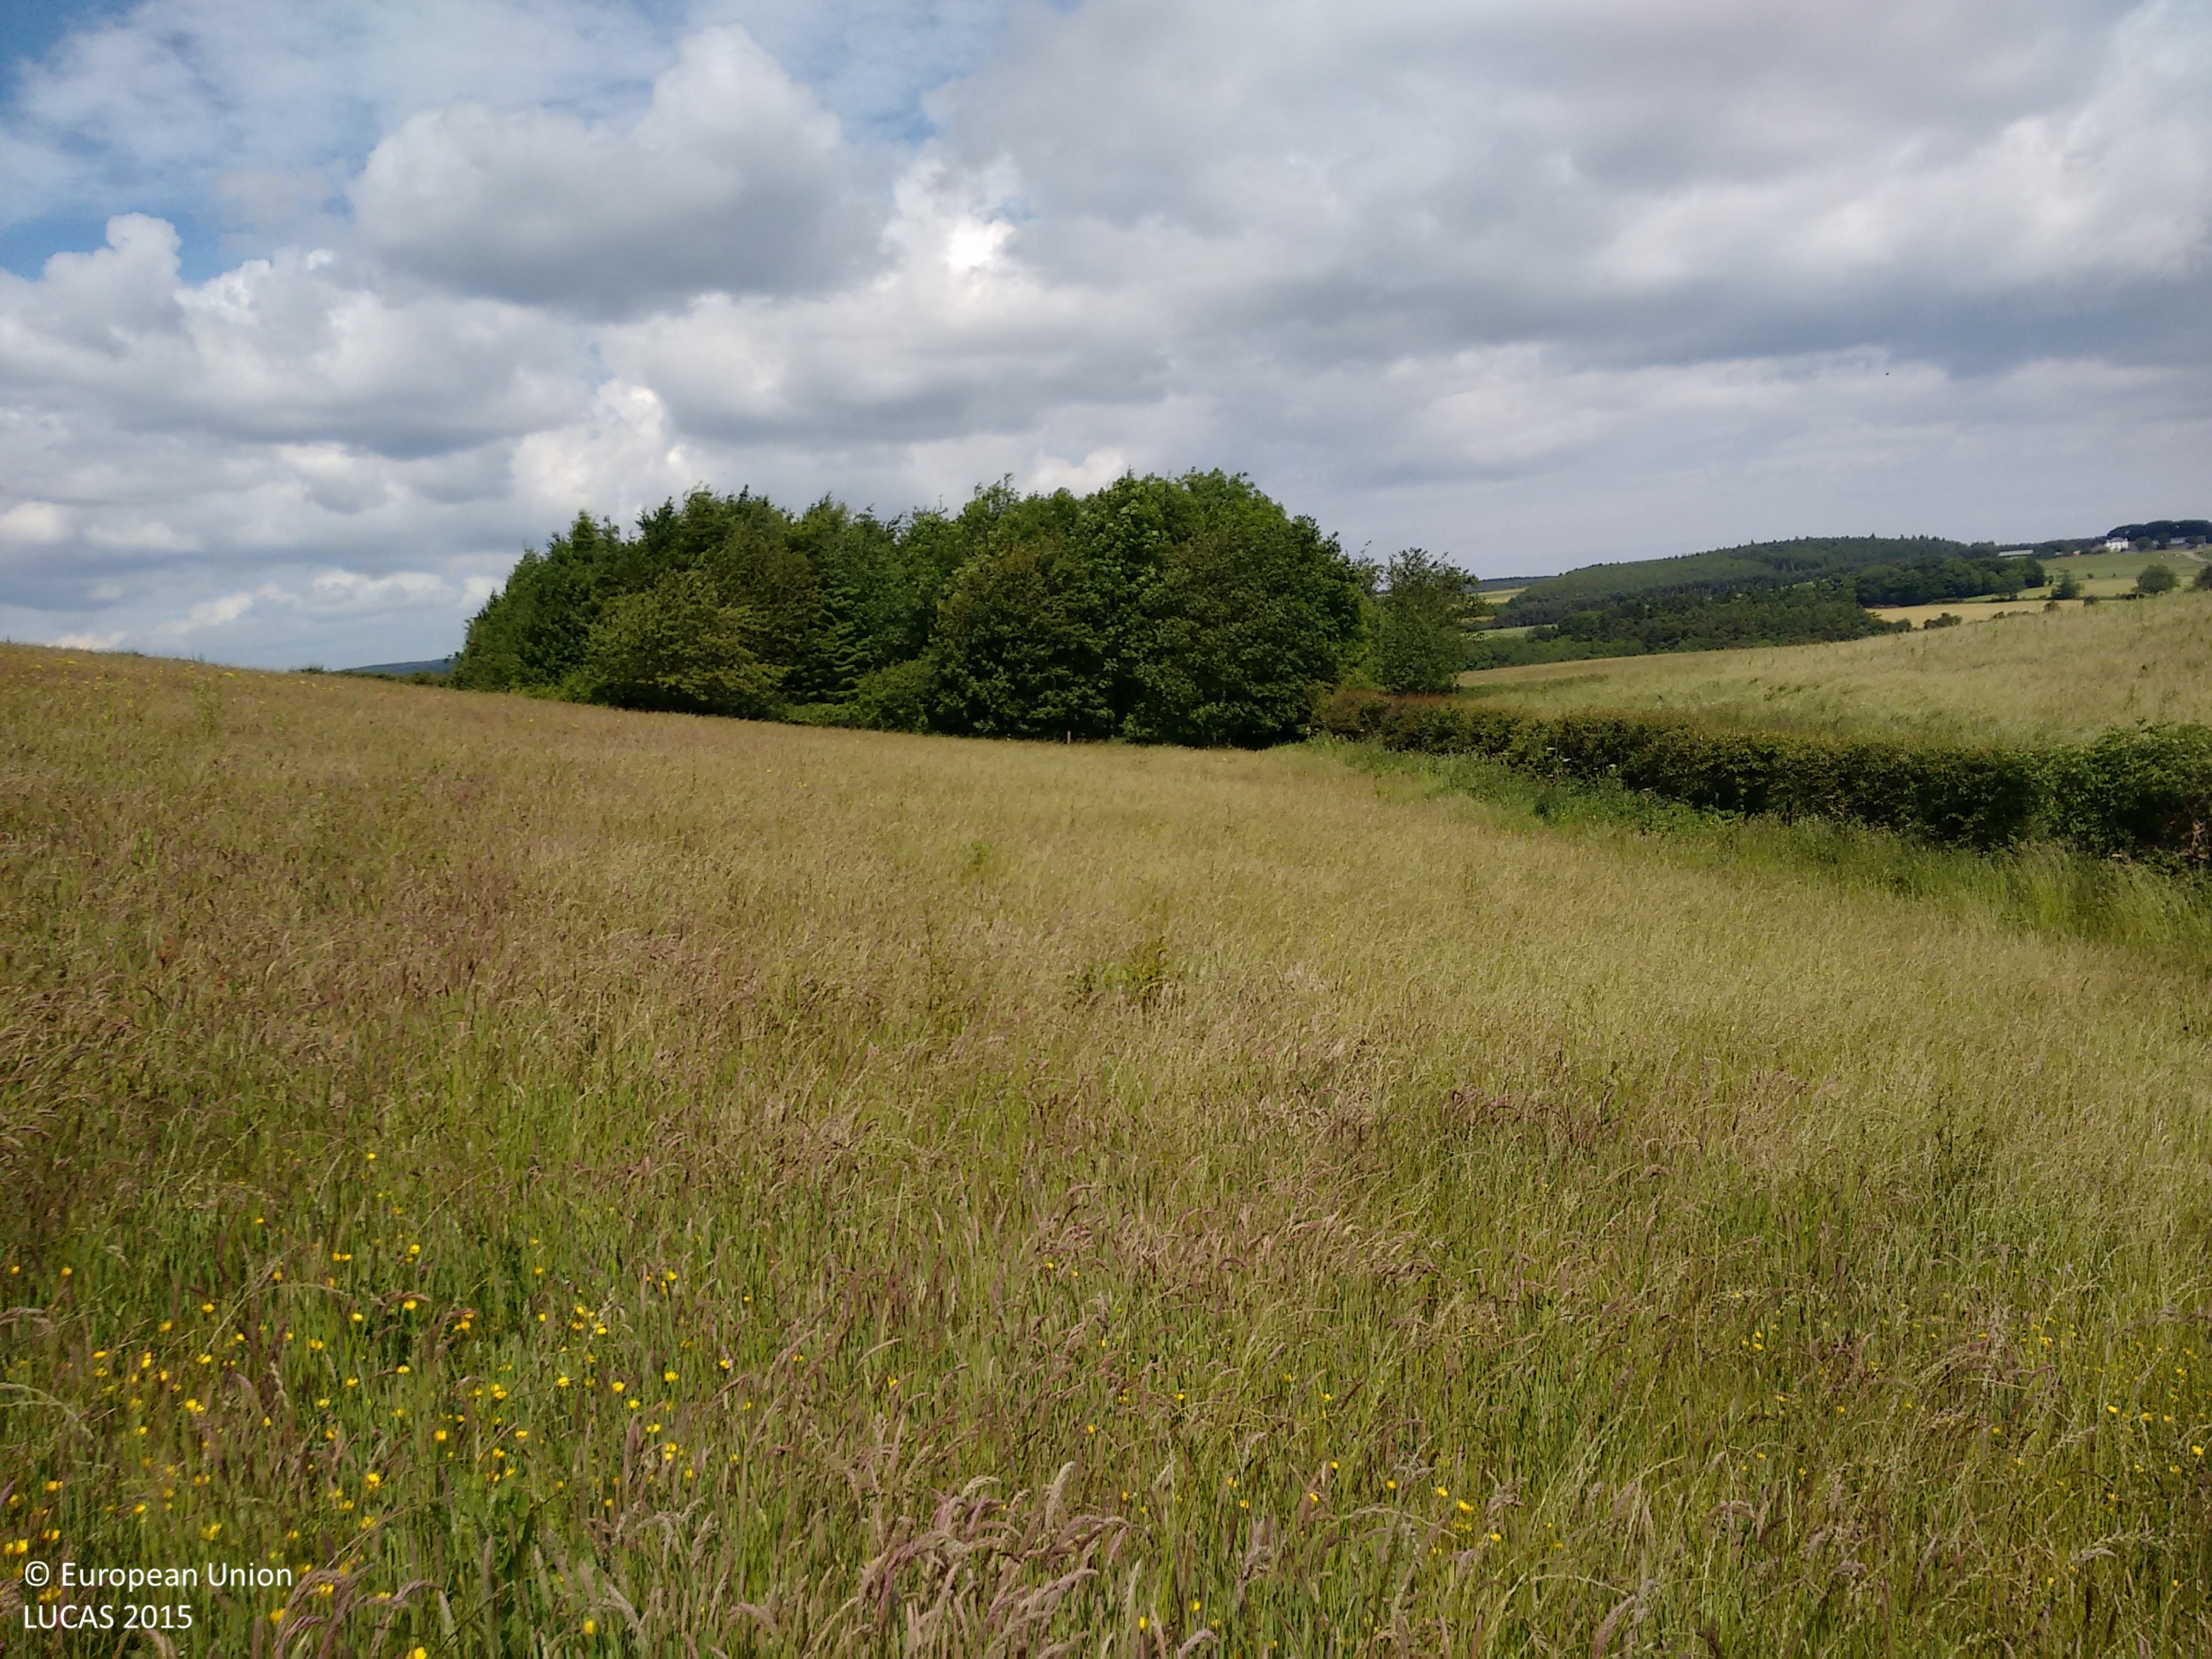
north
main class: Grassland
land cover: Grassland without tree/shrub cover
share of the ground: > 75 %
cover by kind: herbaceous plants 100 %
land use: Agriculture (excluding fallow land and kitchen gardens)
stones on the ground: < 10 %
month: June
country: GB
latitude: 54.3246
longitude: -0.4757
